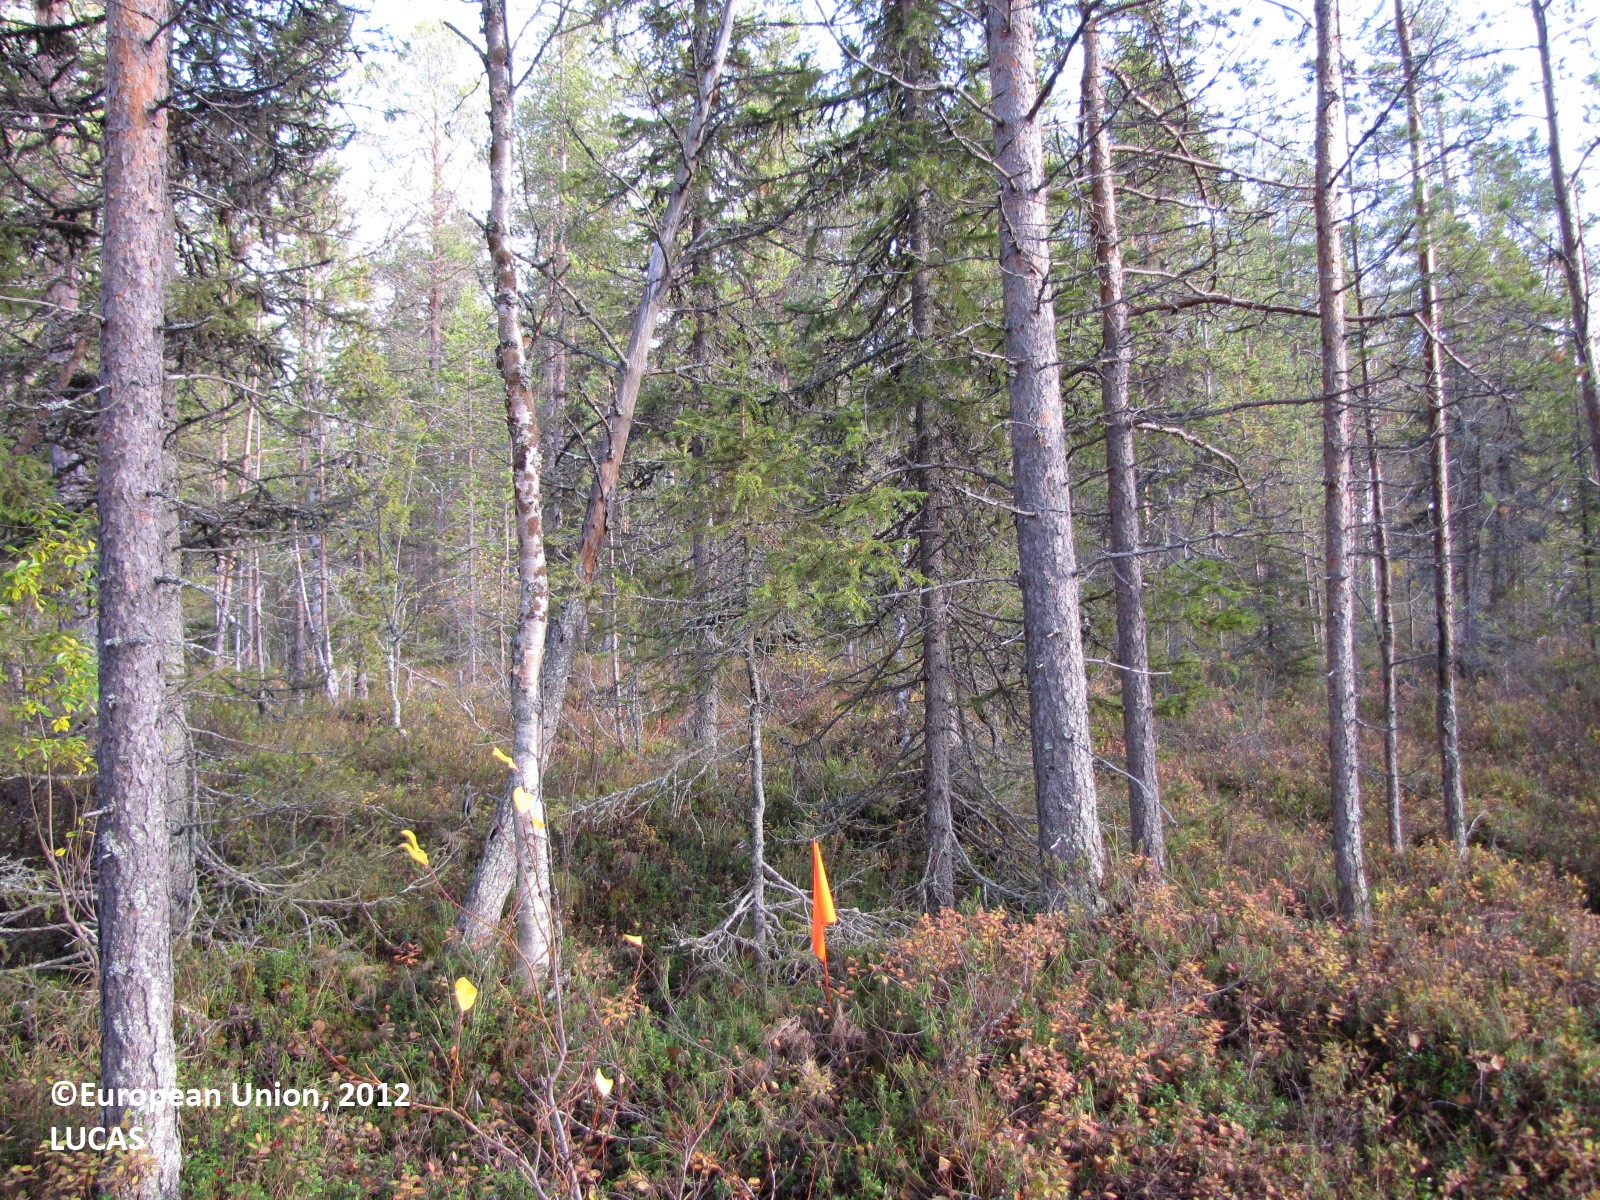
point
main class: Woodland
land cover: Pine dominated coniferous woodland
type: boreal forest
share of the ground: 25 - 50 %
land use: Forestry
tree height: > 5 m
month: September
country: FI
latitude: 67.8421
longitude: 23.6269
